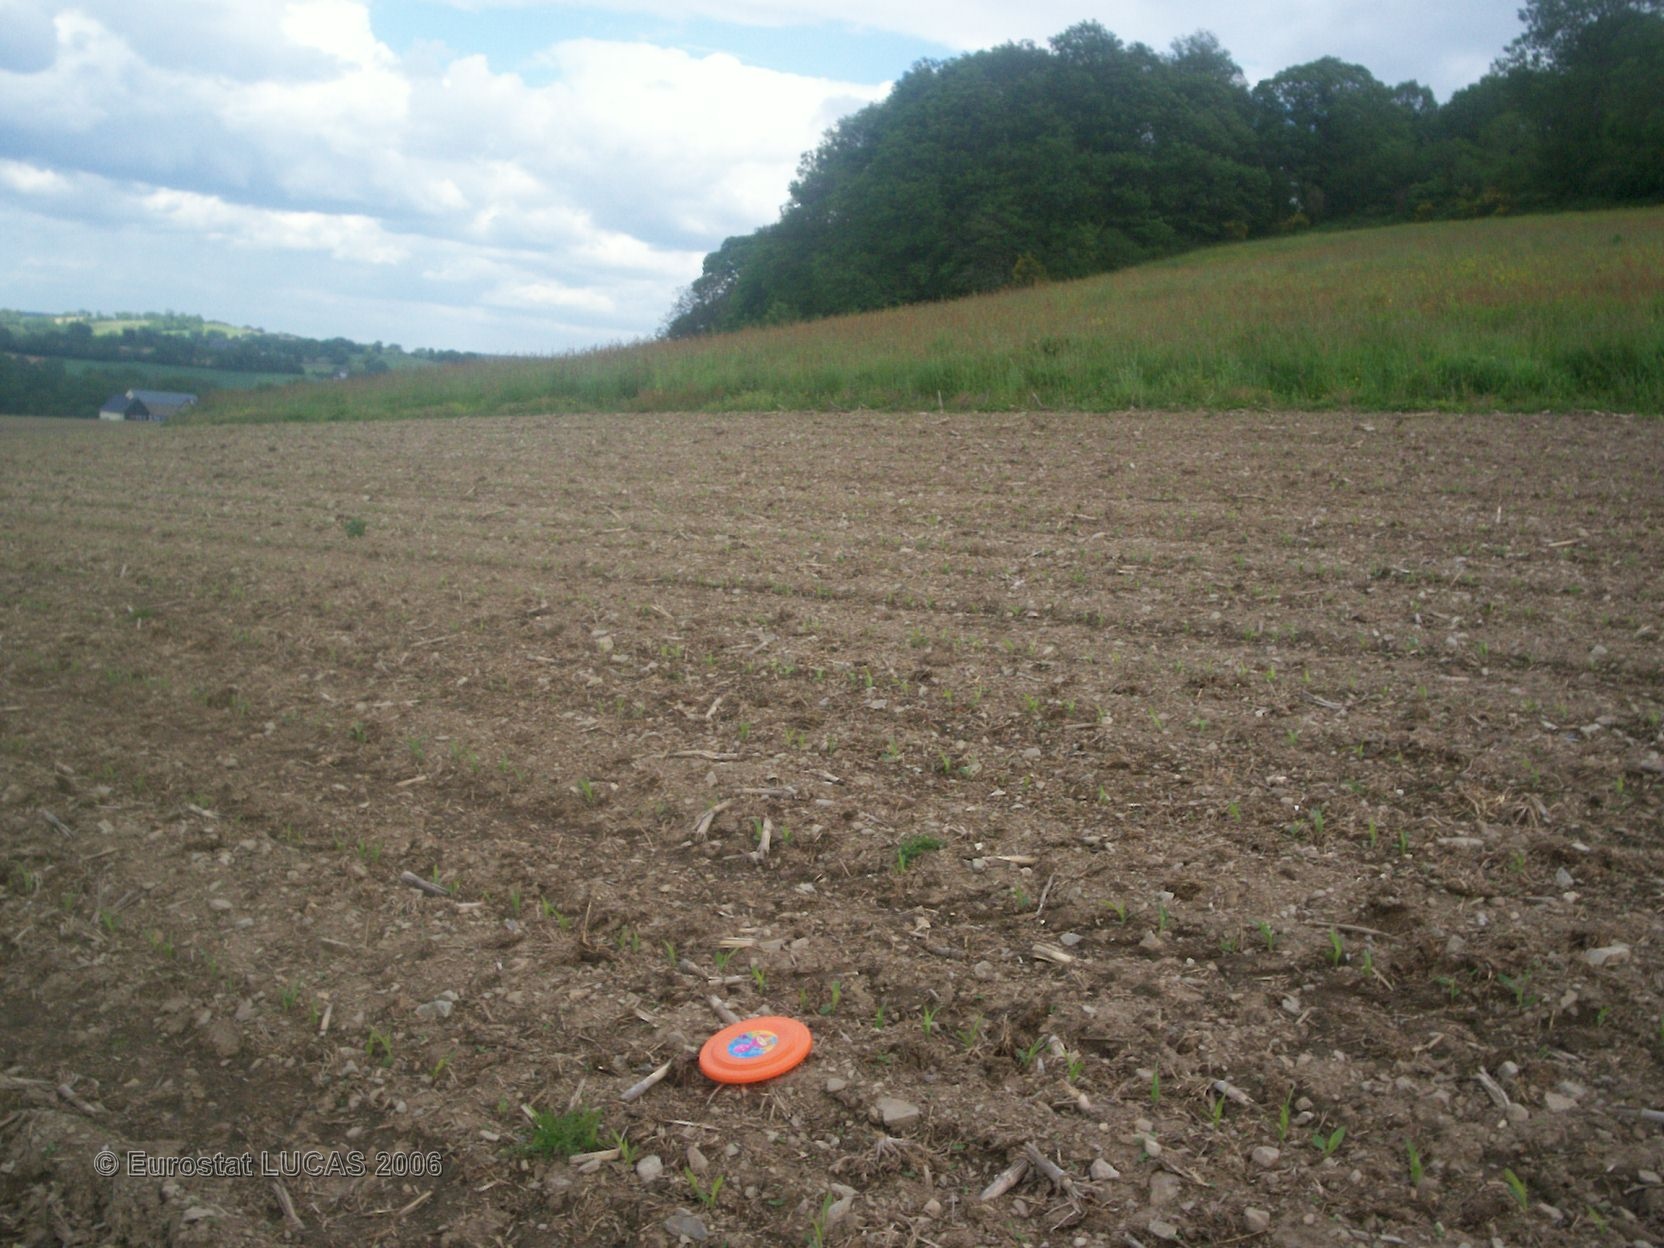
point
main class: Cropland
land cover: Maize
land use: Agriculture (excluding fallow land and kitchen gardens)
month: May
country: FR
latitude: 48.1808
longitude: -0.2392
